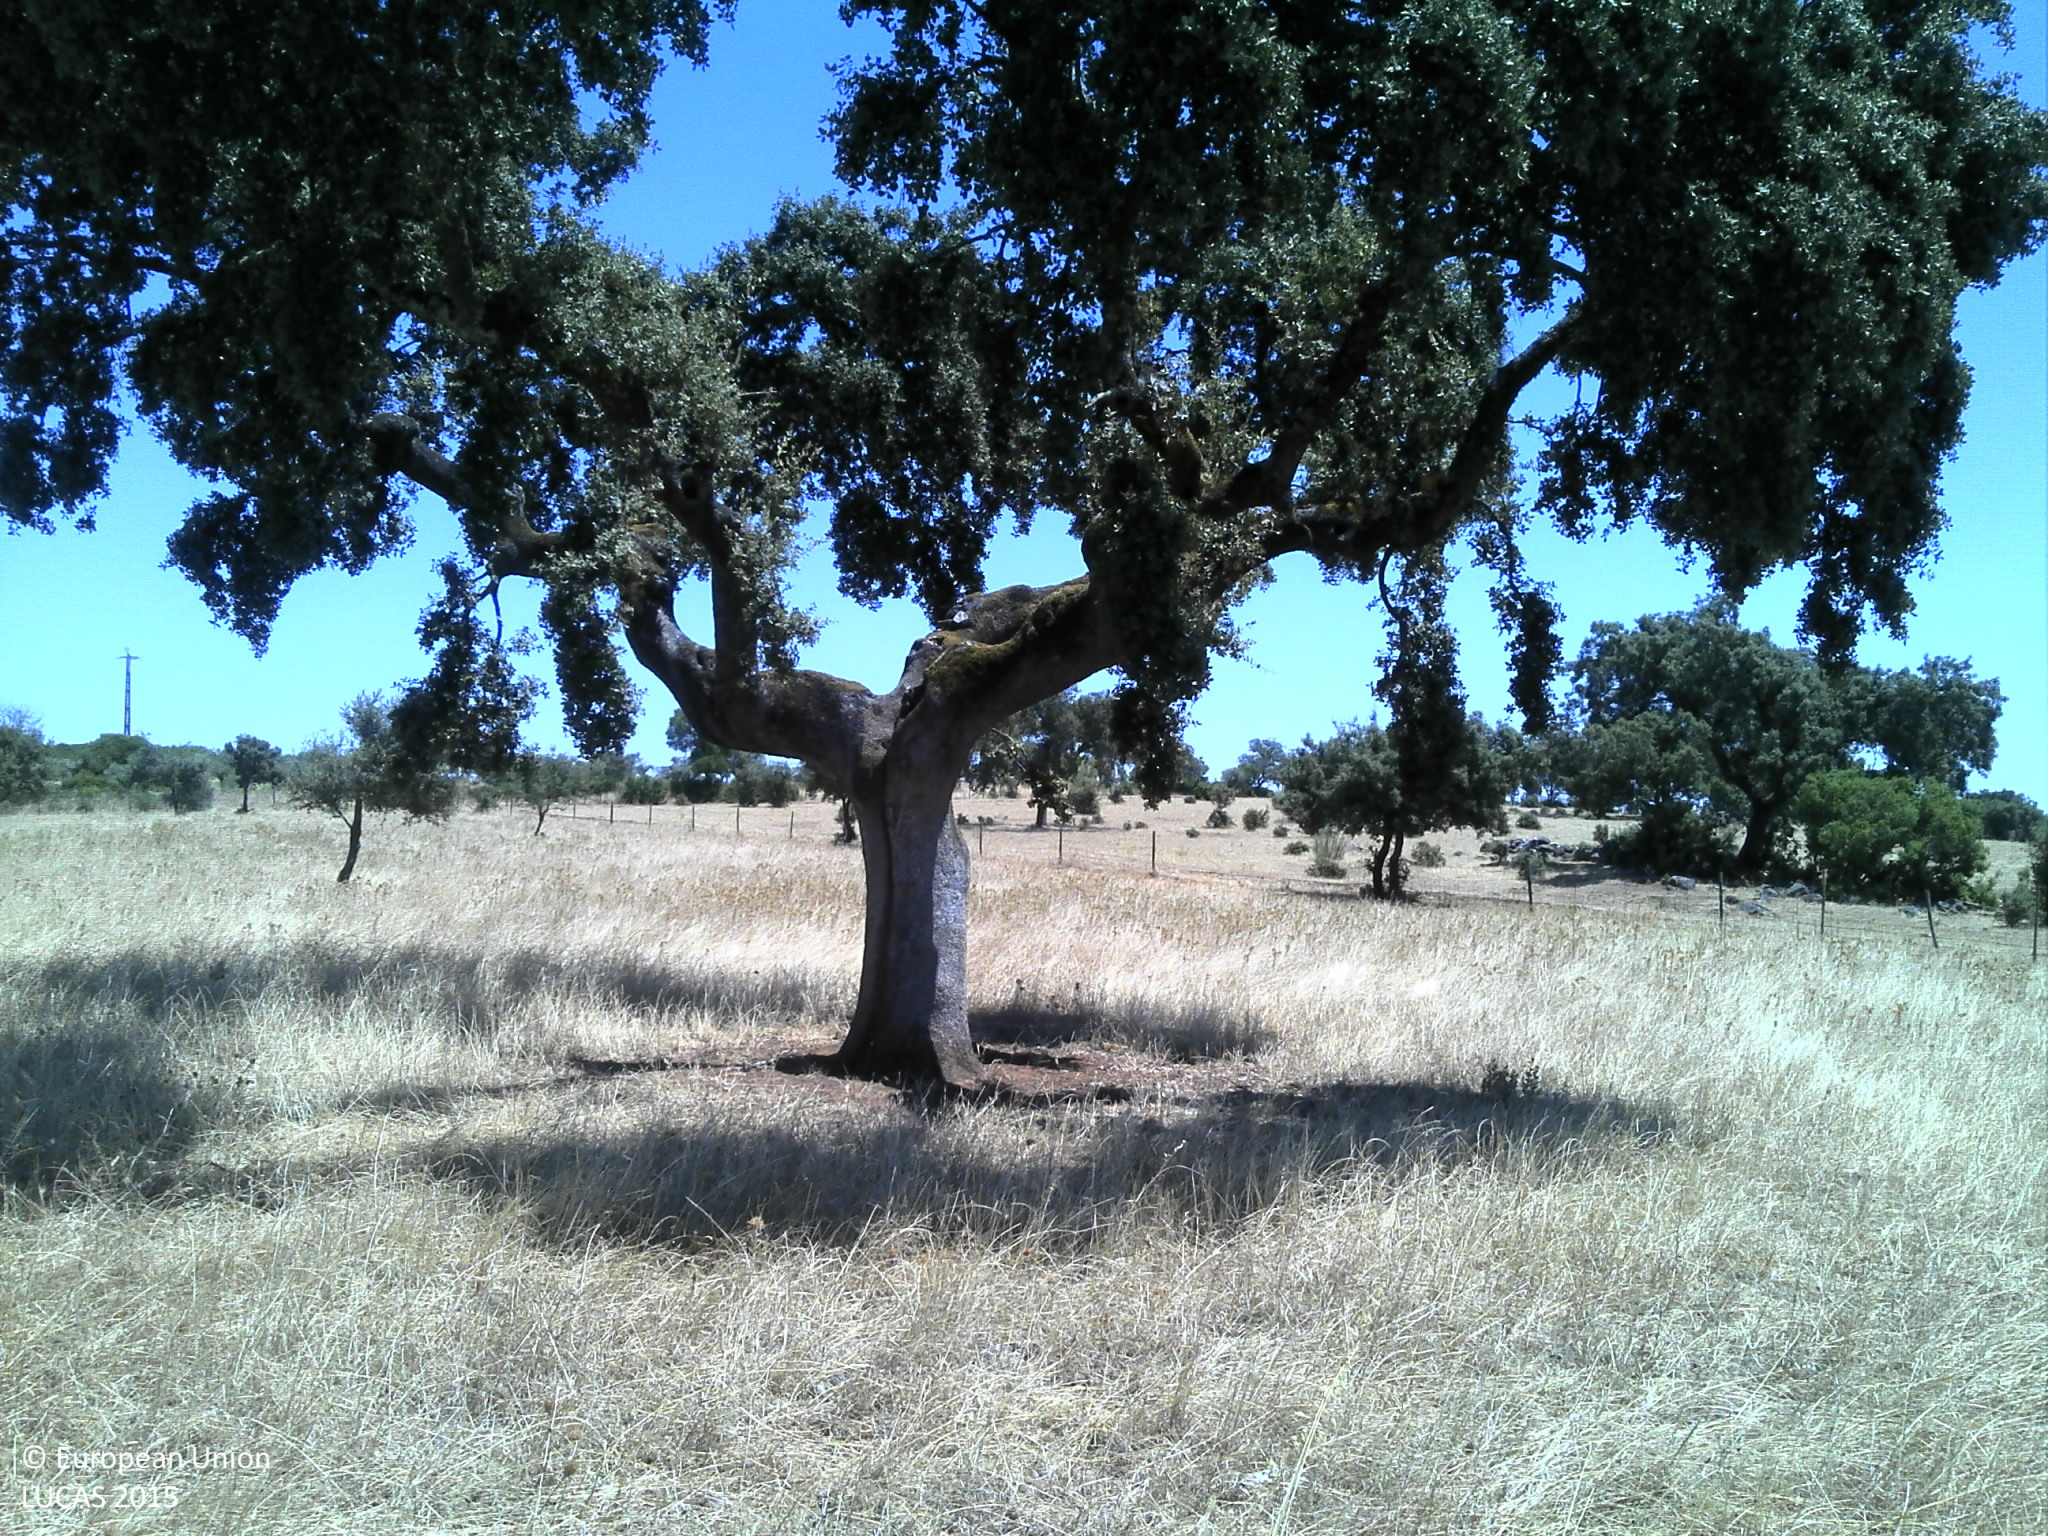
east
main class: Woodland
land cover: Broadleaved woodland
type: broadleaved evergreen forest
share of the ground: 10 - 25 %
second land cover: Grassland without tree/shrub cover
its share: 25 - 50 %
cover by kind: unconsolidated bare surface 55 %, herbaceous plants 25 %, broadleaved forest trees 20 %
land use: Forestry
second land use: Agriculture (excluding fallow land and kitchen gardens)
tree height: > 5 m
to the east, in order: Broadleaved woodland; Grassland without tree/shrub cover; Broadleaved woodland; Other structural elements; Grass margins; Fences; Grass margins; Other structural elements; Grassland with sparse tree/shrub cover; Other structural elements; Grass margins; Fences; Grass margins; Paved roads, cycling and walking lanes; Grass margins; Shruby margins; Fences; Grass margins; Fences; Olive groves; Other structural elements; Olive groves
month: July
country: PT
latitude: 39.1299
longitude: -7.5670
